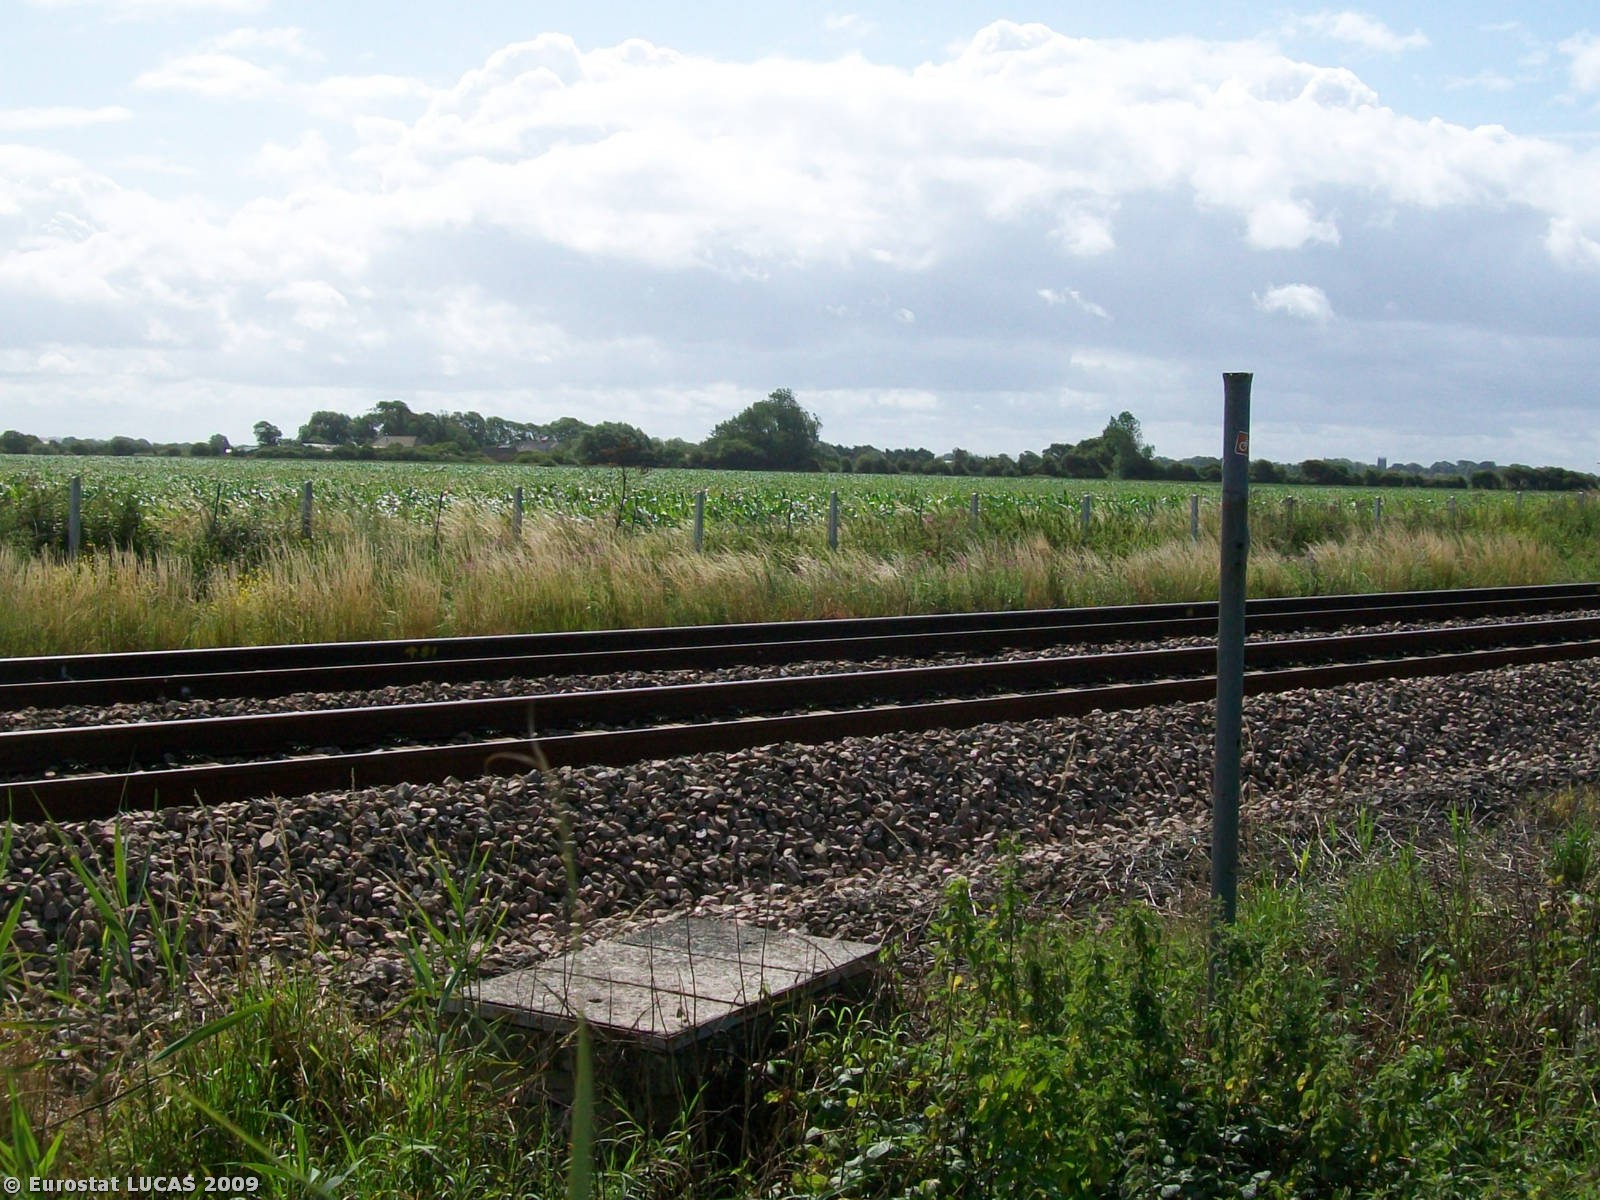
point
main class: Cropland
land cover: Maize
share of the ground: > 75 %
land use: Agriculture (excluding fallow land and kitchen gardens)
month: July
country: GB
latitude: 51.2979
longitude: -2.9679
